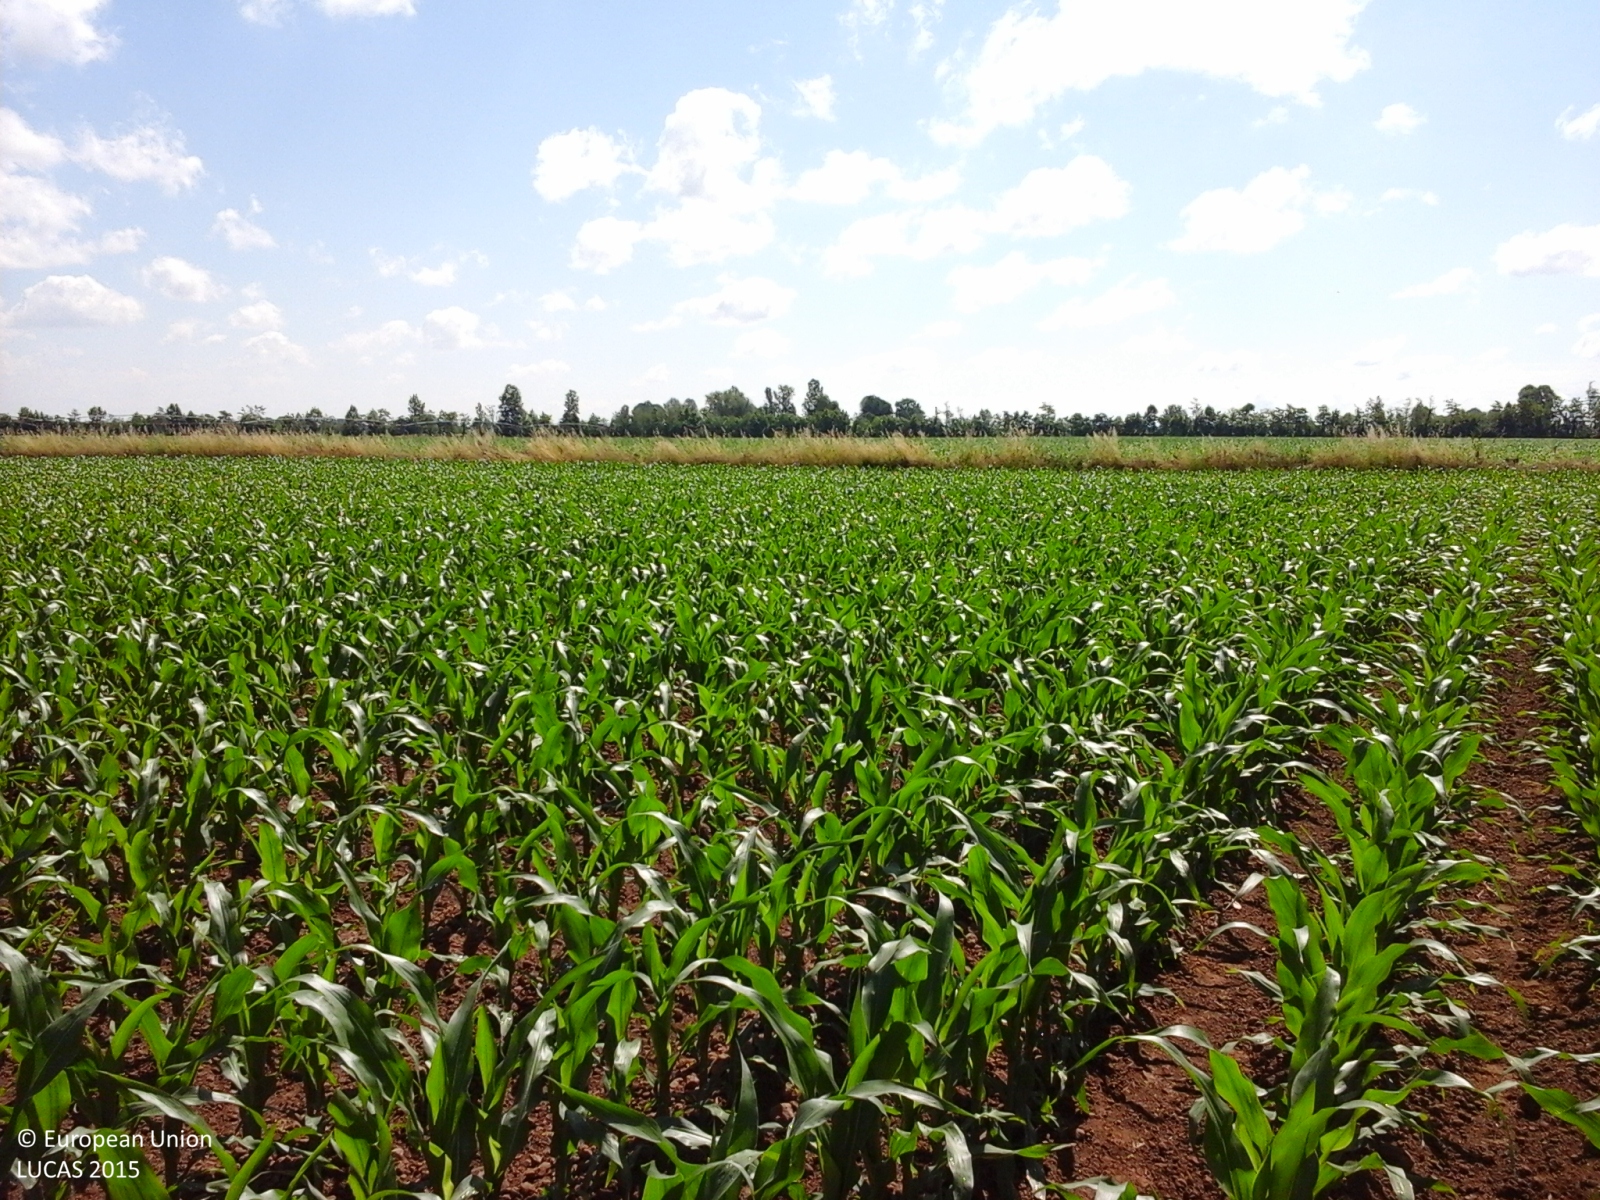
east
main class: Cropland
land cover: Maize
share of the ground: > 75 %
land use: Agriculture (excluding fallow land and kitchen gardens)
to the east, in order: Maize; Grass margins; Ditches and canals; Grass margins; Tracks; Maize
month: May
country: IT
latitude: 45.3240
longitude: 10.1655
